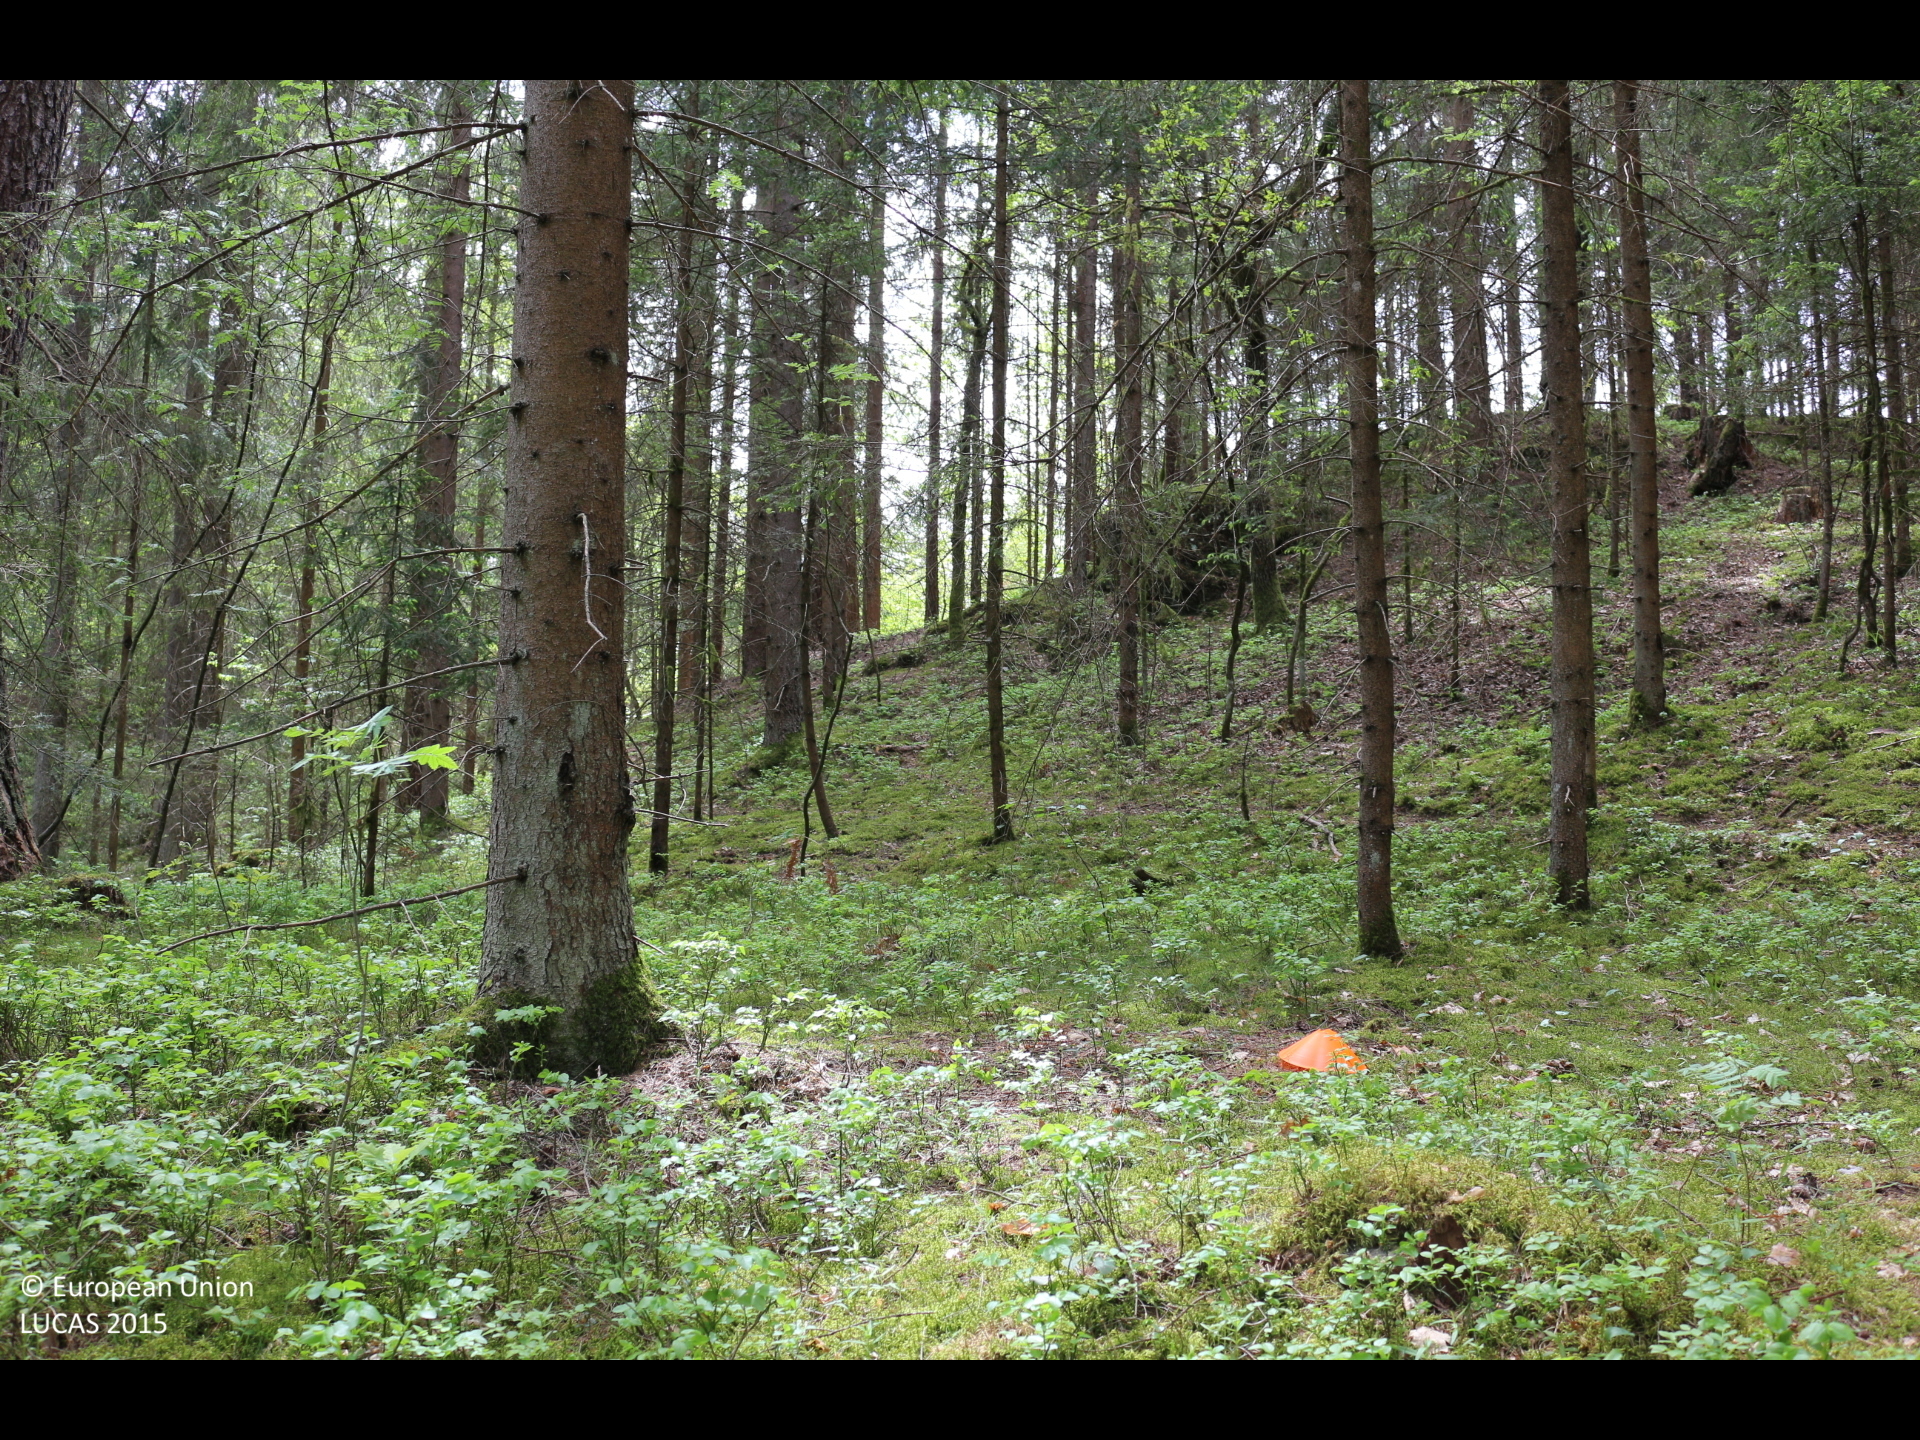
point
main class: Woodland
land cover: Spruce dominated coniferous woodland
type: alpine coniferous forest
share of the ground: > 75 %
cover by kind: coniferous forest trees 100 %
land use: Forestry
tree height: > 5 m
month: May
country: AT
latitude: 46.6447
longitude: 14.2697
